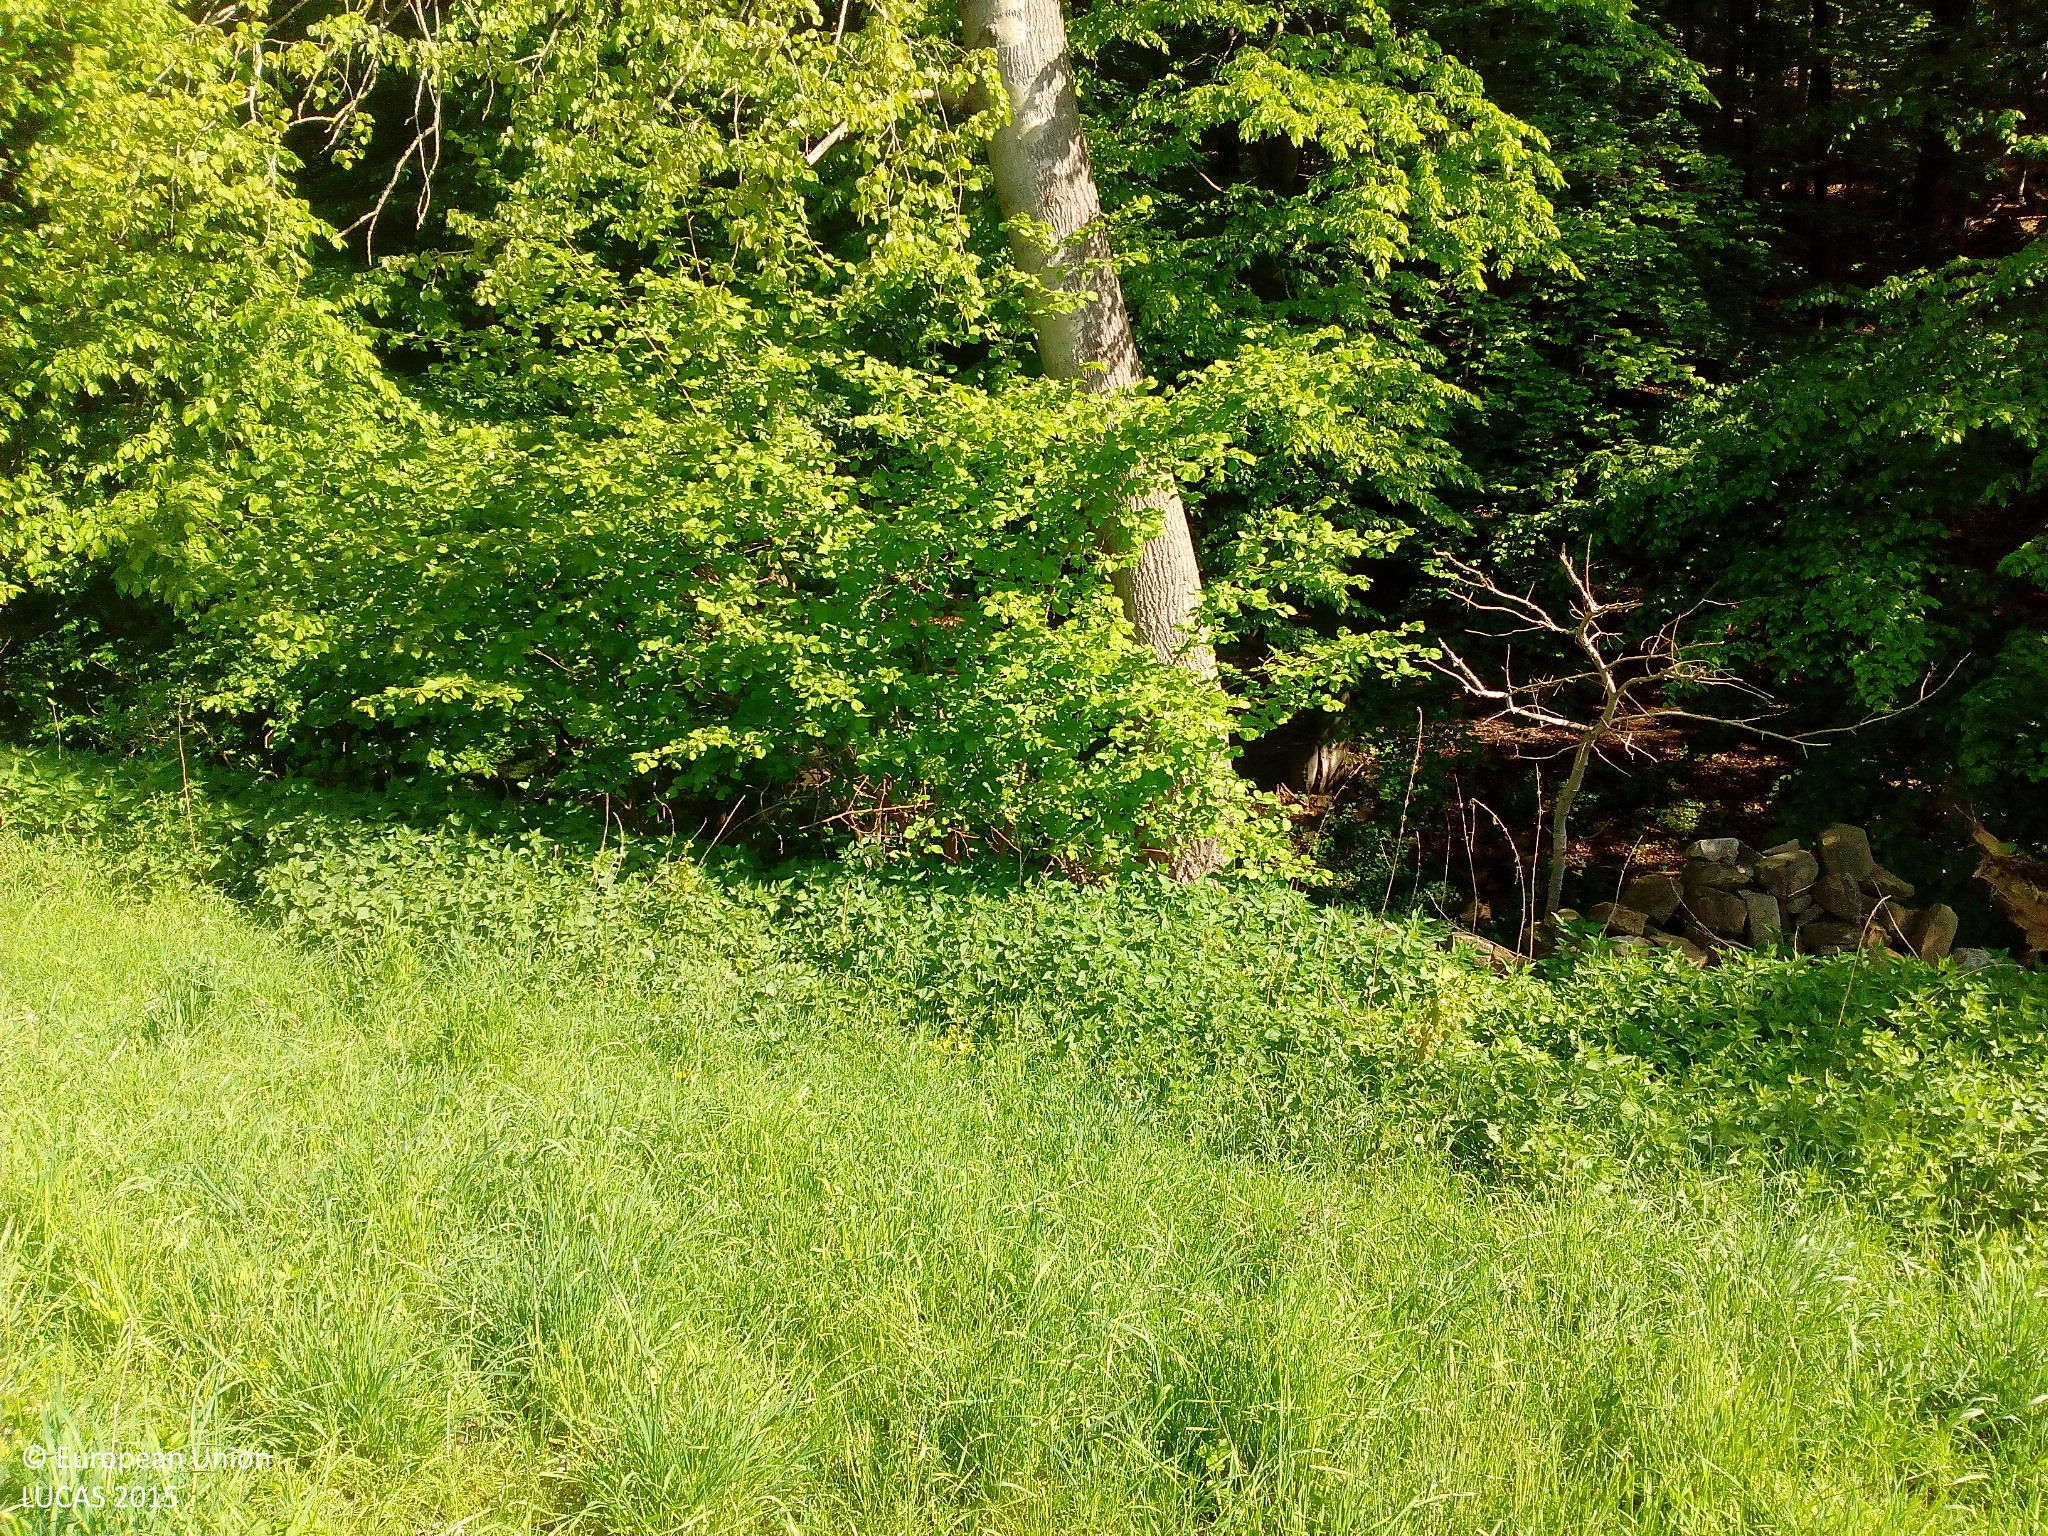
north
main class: Grassland
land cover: Grassland without tree/shrub cover
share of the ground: > 75 %
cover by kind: herbaceous plants 100 %
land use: Agriculture (excluding fallow land and kitchen gardens)
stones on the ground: < 10 %
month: May
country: DE
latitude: 51.2629
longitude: 9.8711
